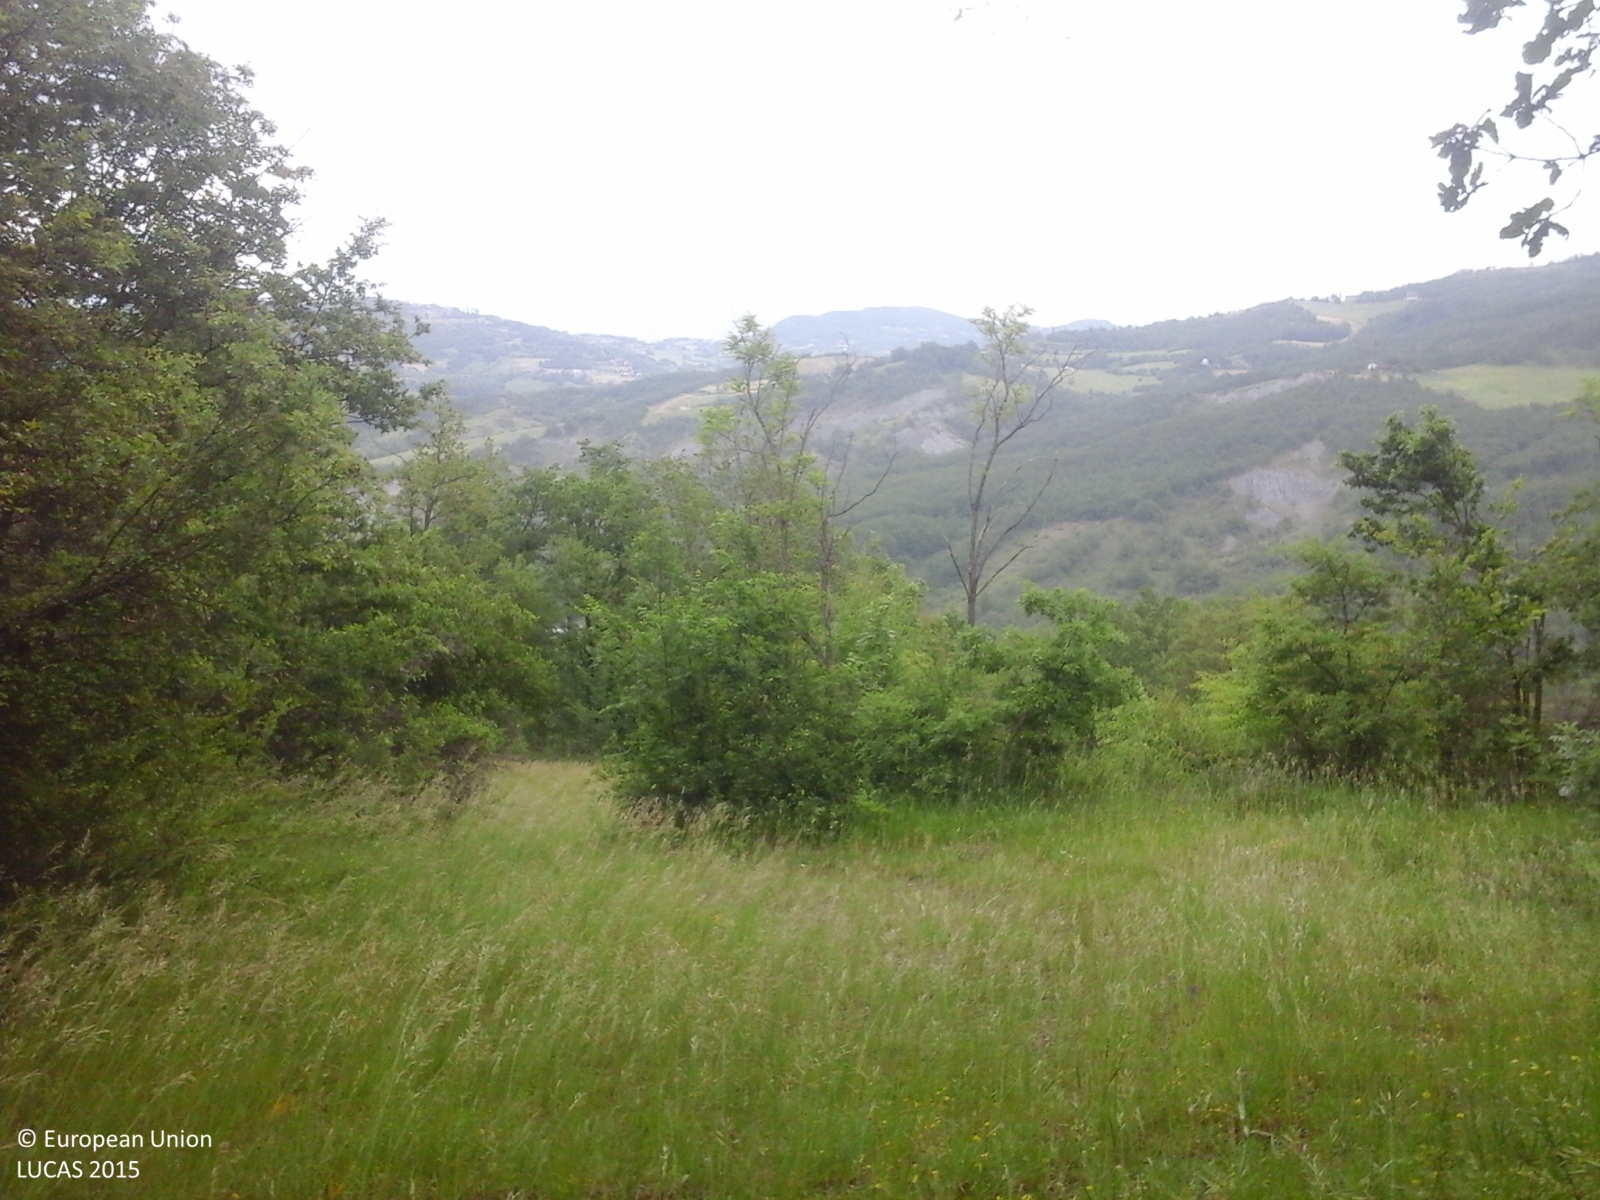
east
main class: Woodland
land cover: Broadleaved woodland
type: thermophilous deciduous forest
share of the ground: > 75 %
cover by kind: broadleaved forest trees 90 %, shrubs 10 %
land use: Forestry
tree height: > 5 m
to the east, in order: Broadleaved woodland; Grassland without tree/shrub cover; Broadleaved woodland; Ditches and canals; Paved roads, cycling and walking lanes; Ditches and canals; Broadleaved woodland; Electric lines; Broadleaved woodland; Shrubland with sparse tree cover
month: May
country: IT
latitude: 44.2748
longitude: 10.8625
